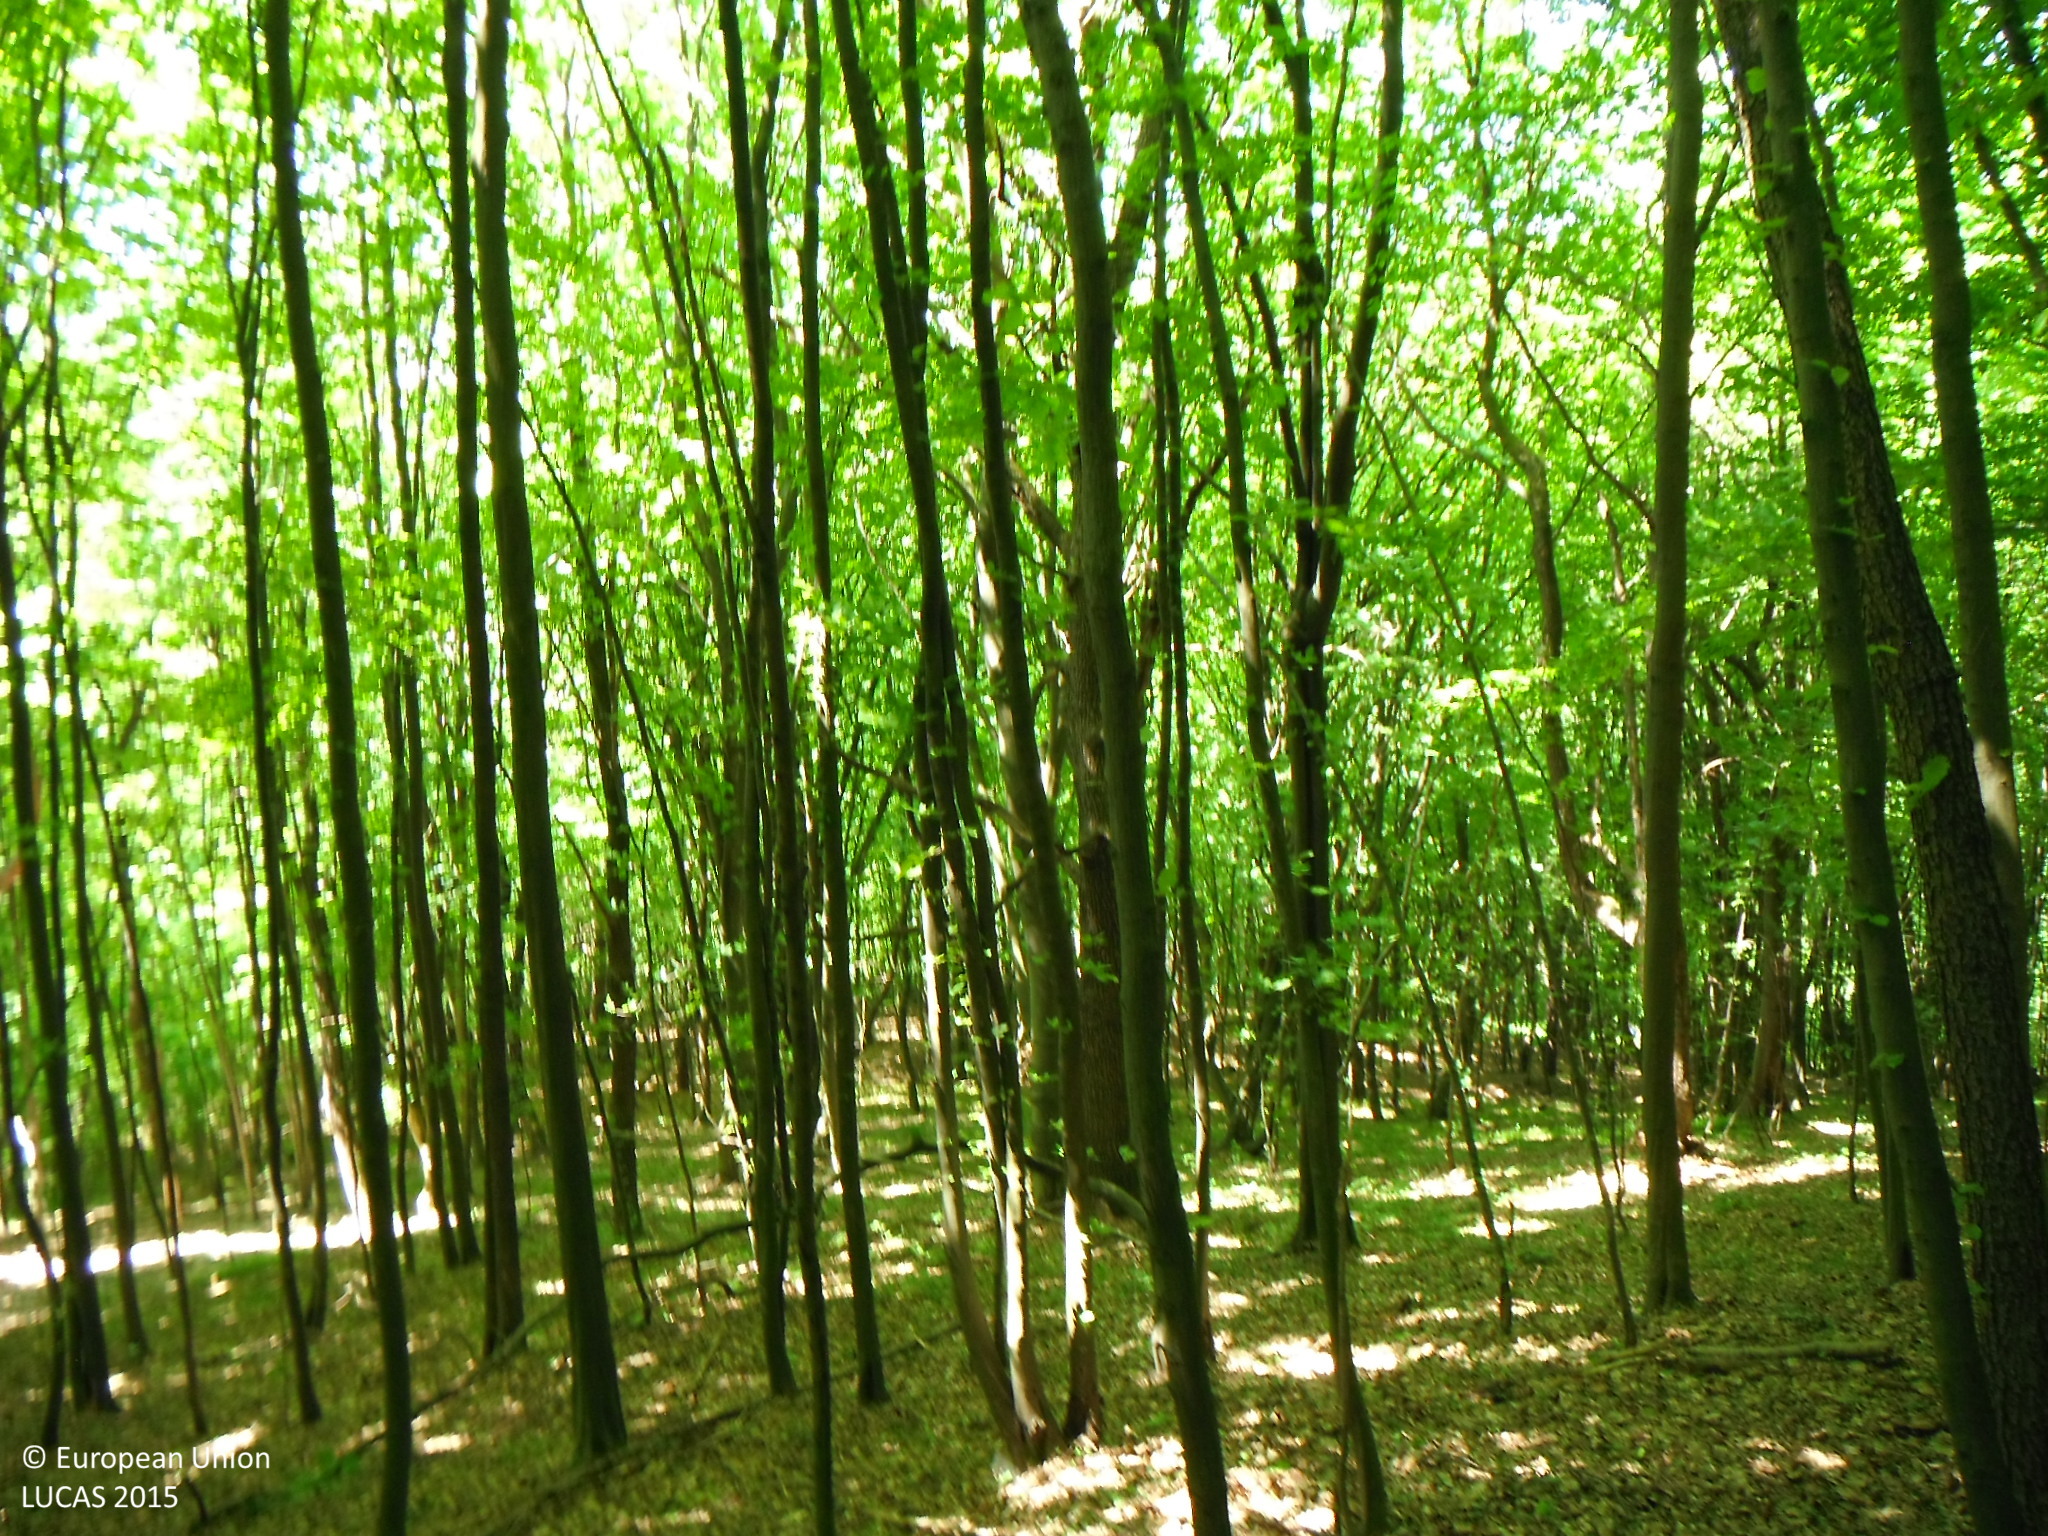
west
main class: Woodland
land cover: Broadleaved woodland
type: mesophytic deciduous forest
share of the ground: > 75 %
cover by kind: broadleaved forest trees 100 %
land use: Forestry
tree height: > 5 m
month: May
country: SK
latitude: 49.1145
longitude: 21.6272
